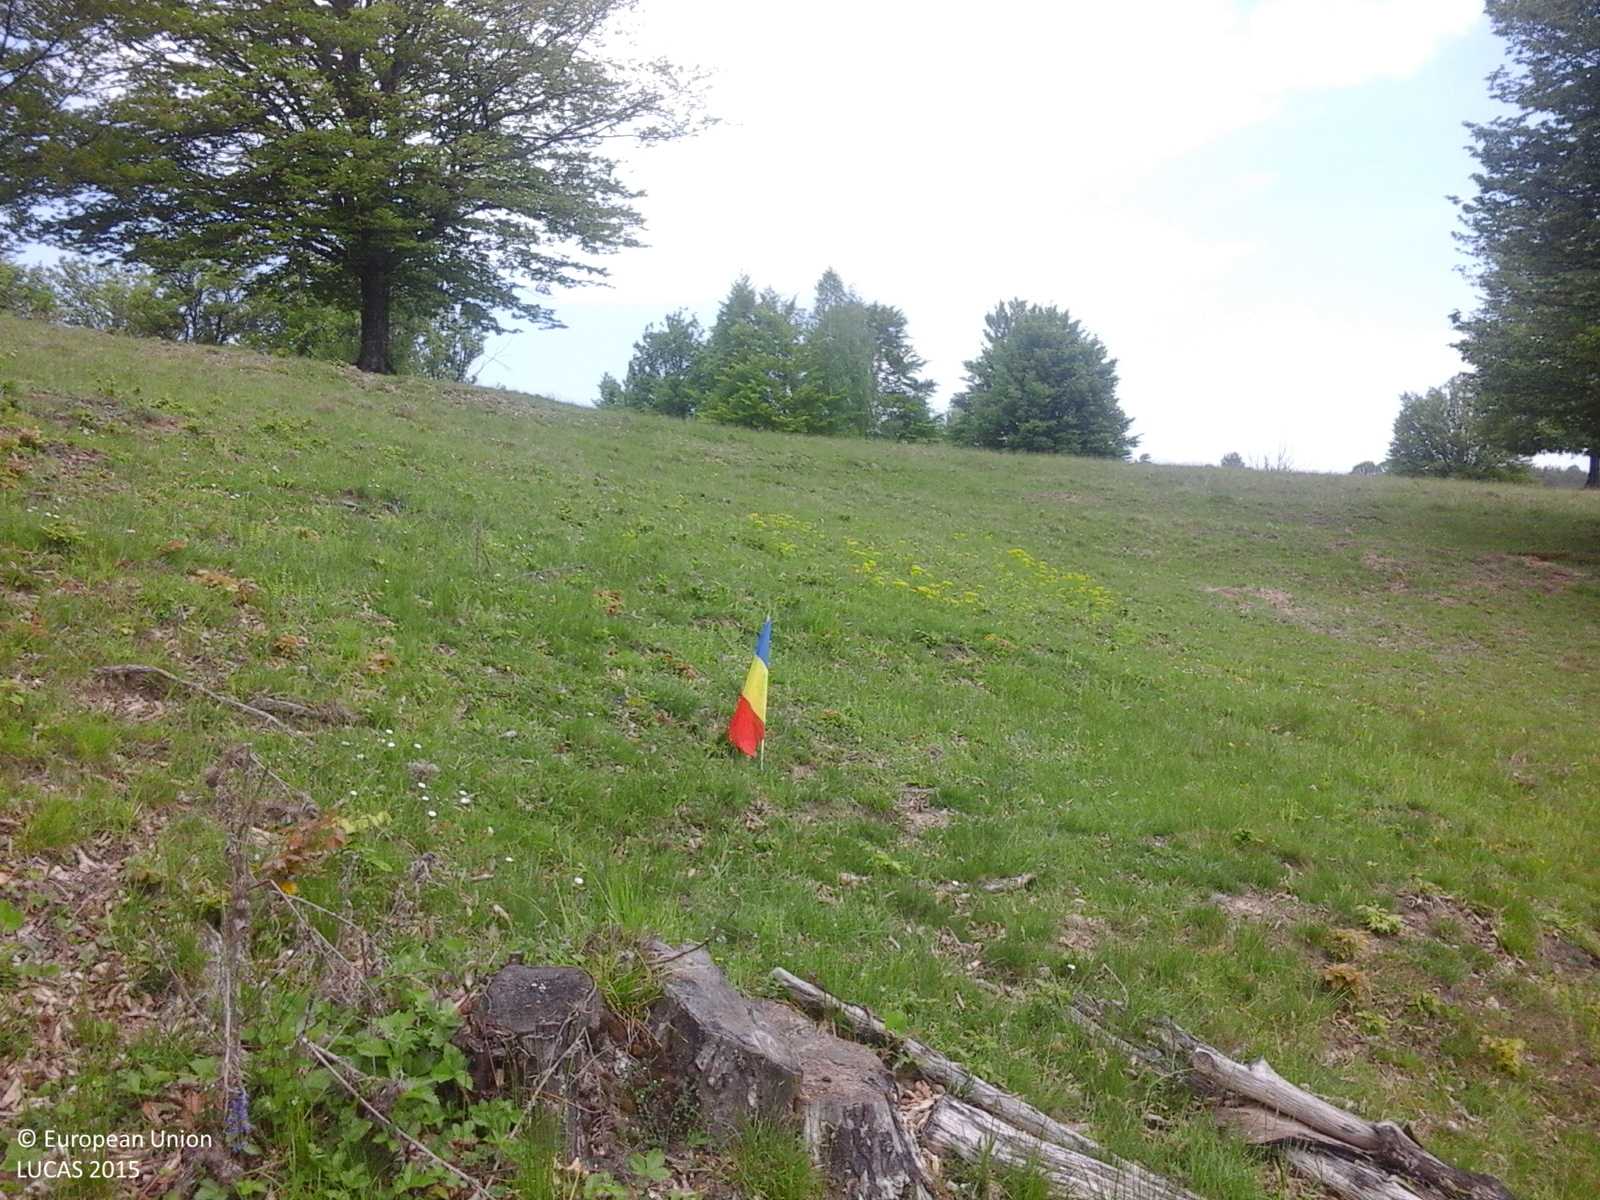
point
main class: Grassland
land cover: Grassland with sparse tree/shrub cover
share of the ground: > 75 %
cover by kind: herbaceous plants 85 %, shrubs 10 %, broadleaved forest trees 5 %
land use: Agriculture (excluding fallow land and kitchen gardens)
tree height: > 5 m
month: May
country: RO
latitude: 45.7403
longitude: 26.0137
